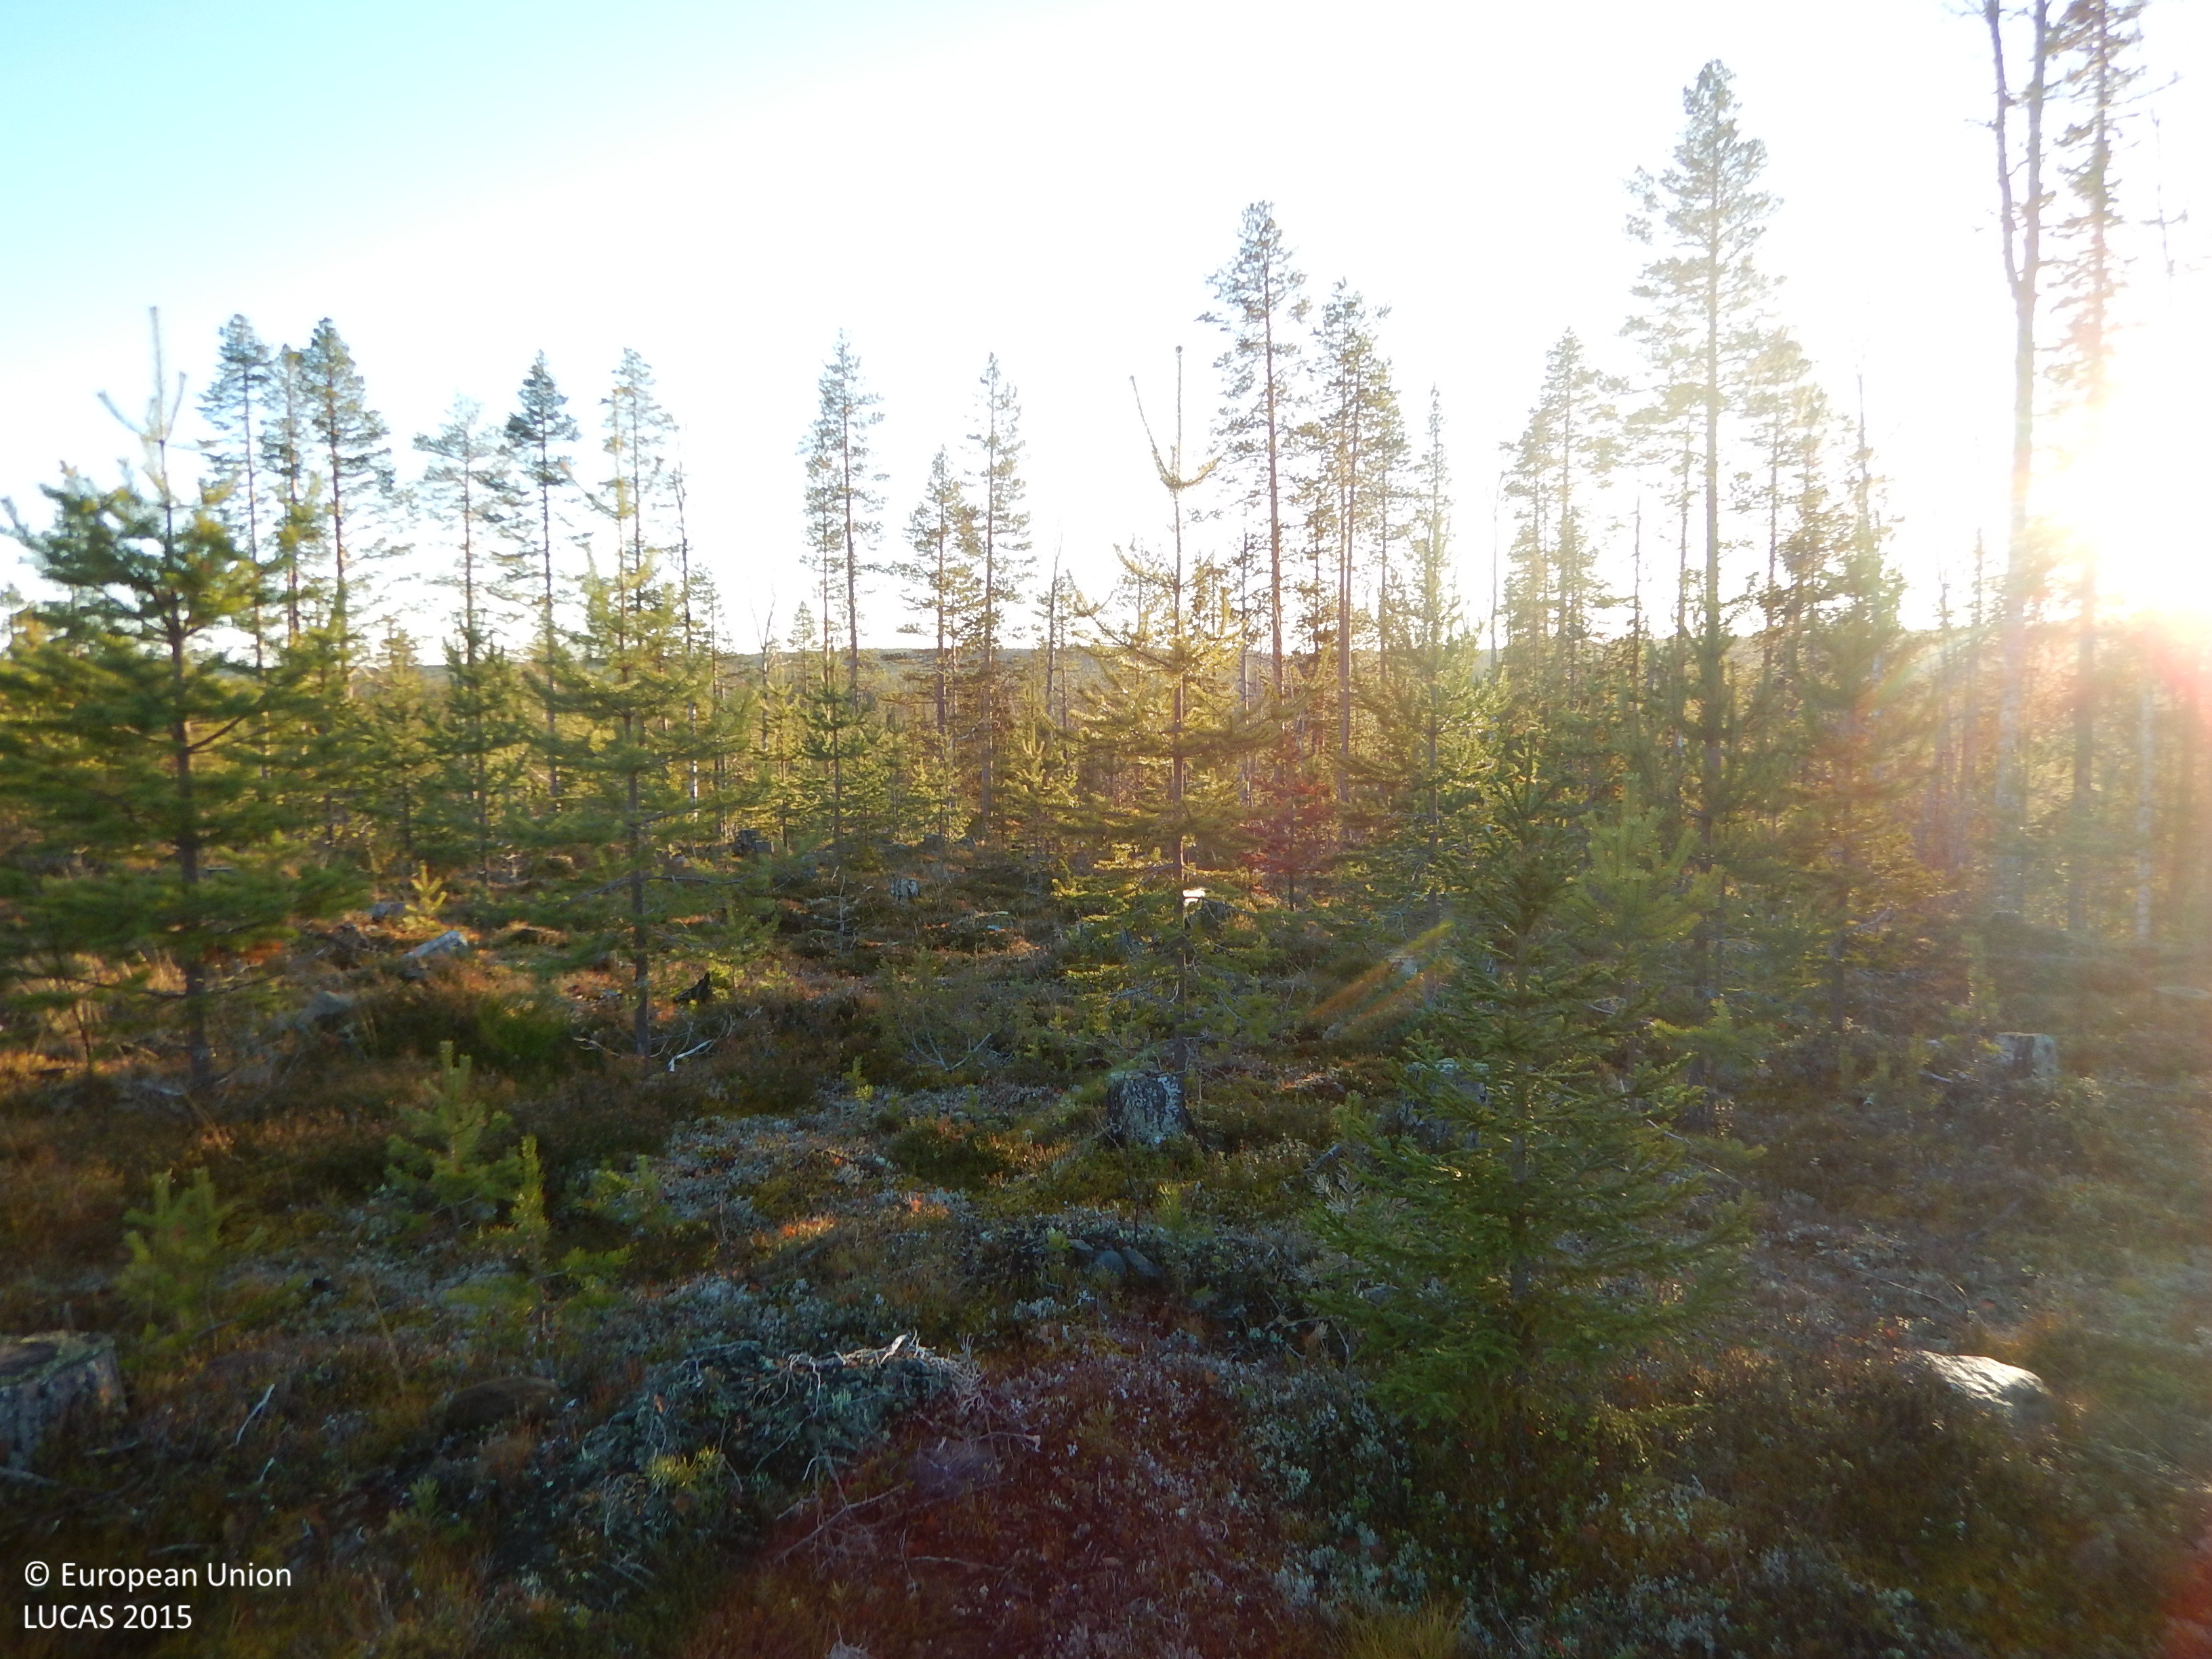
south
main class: Woodland
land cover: Pine dominated coniferous woodland
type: boreal forest
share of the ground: 50 - 75 %
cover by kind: coniferous forest trees 50 %, shrubs 25 %, lichens and mosses 20 %, broadleaved forest trees 5 %
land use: Forestry
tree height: < 5 m
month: November
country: SE
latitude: 65.3718
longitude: 20.6578
